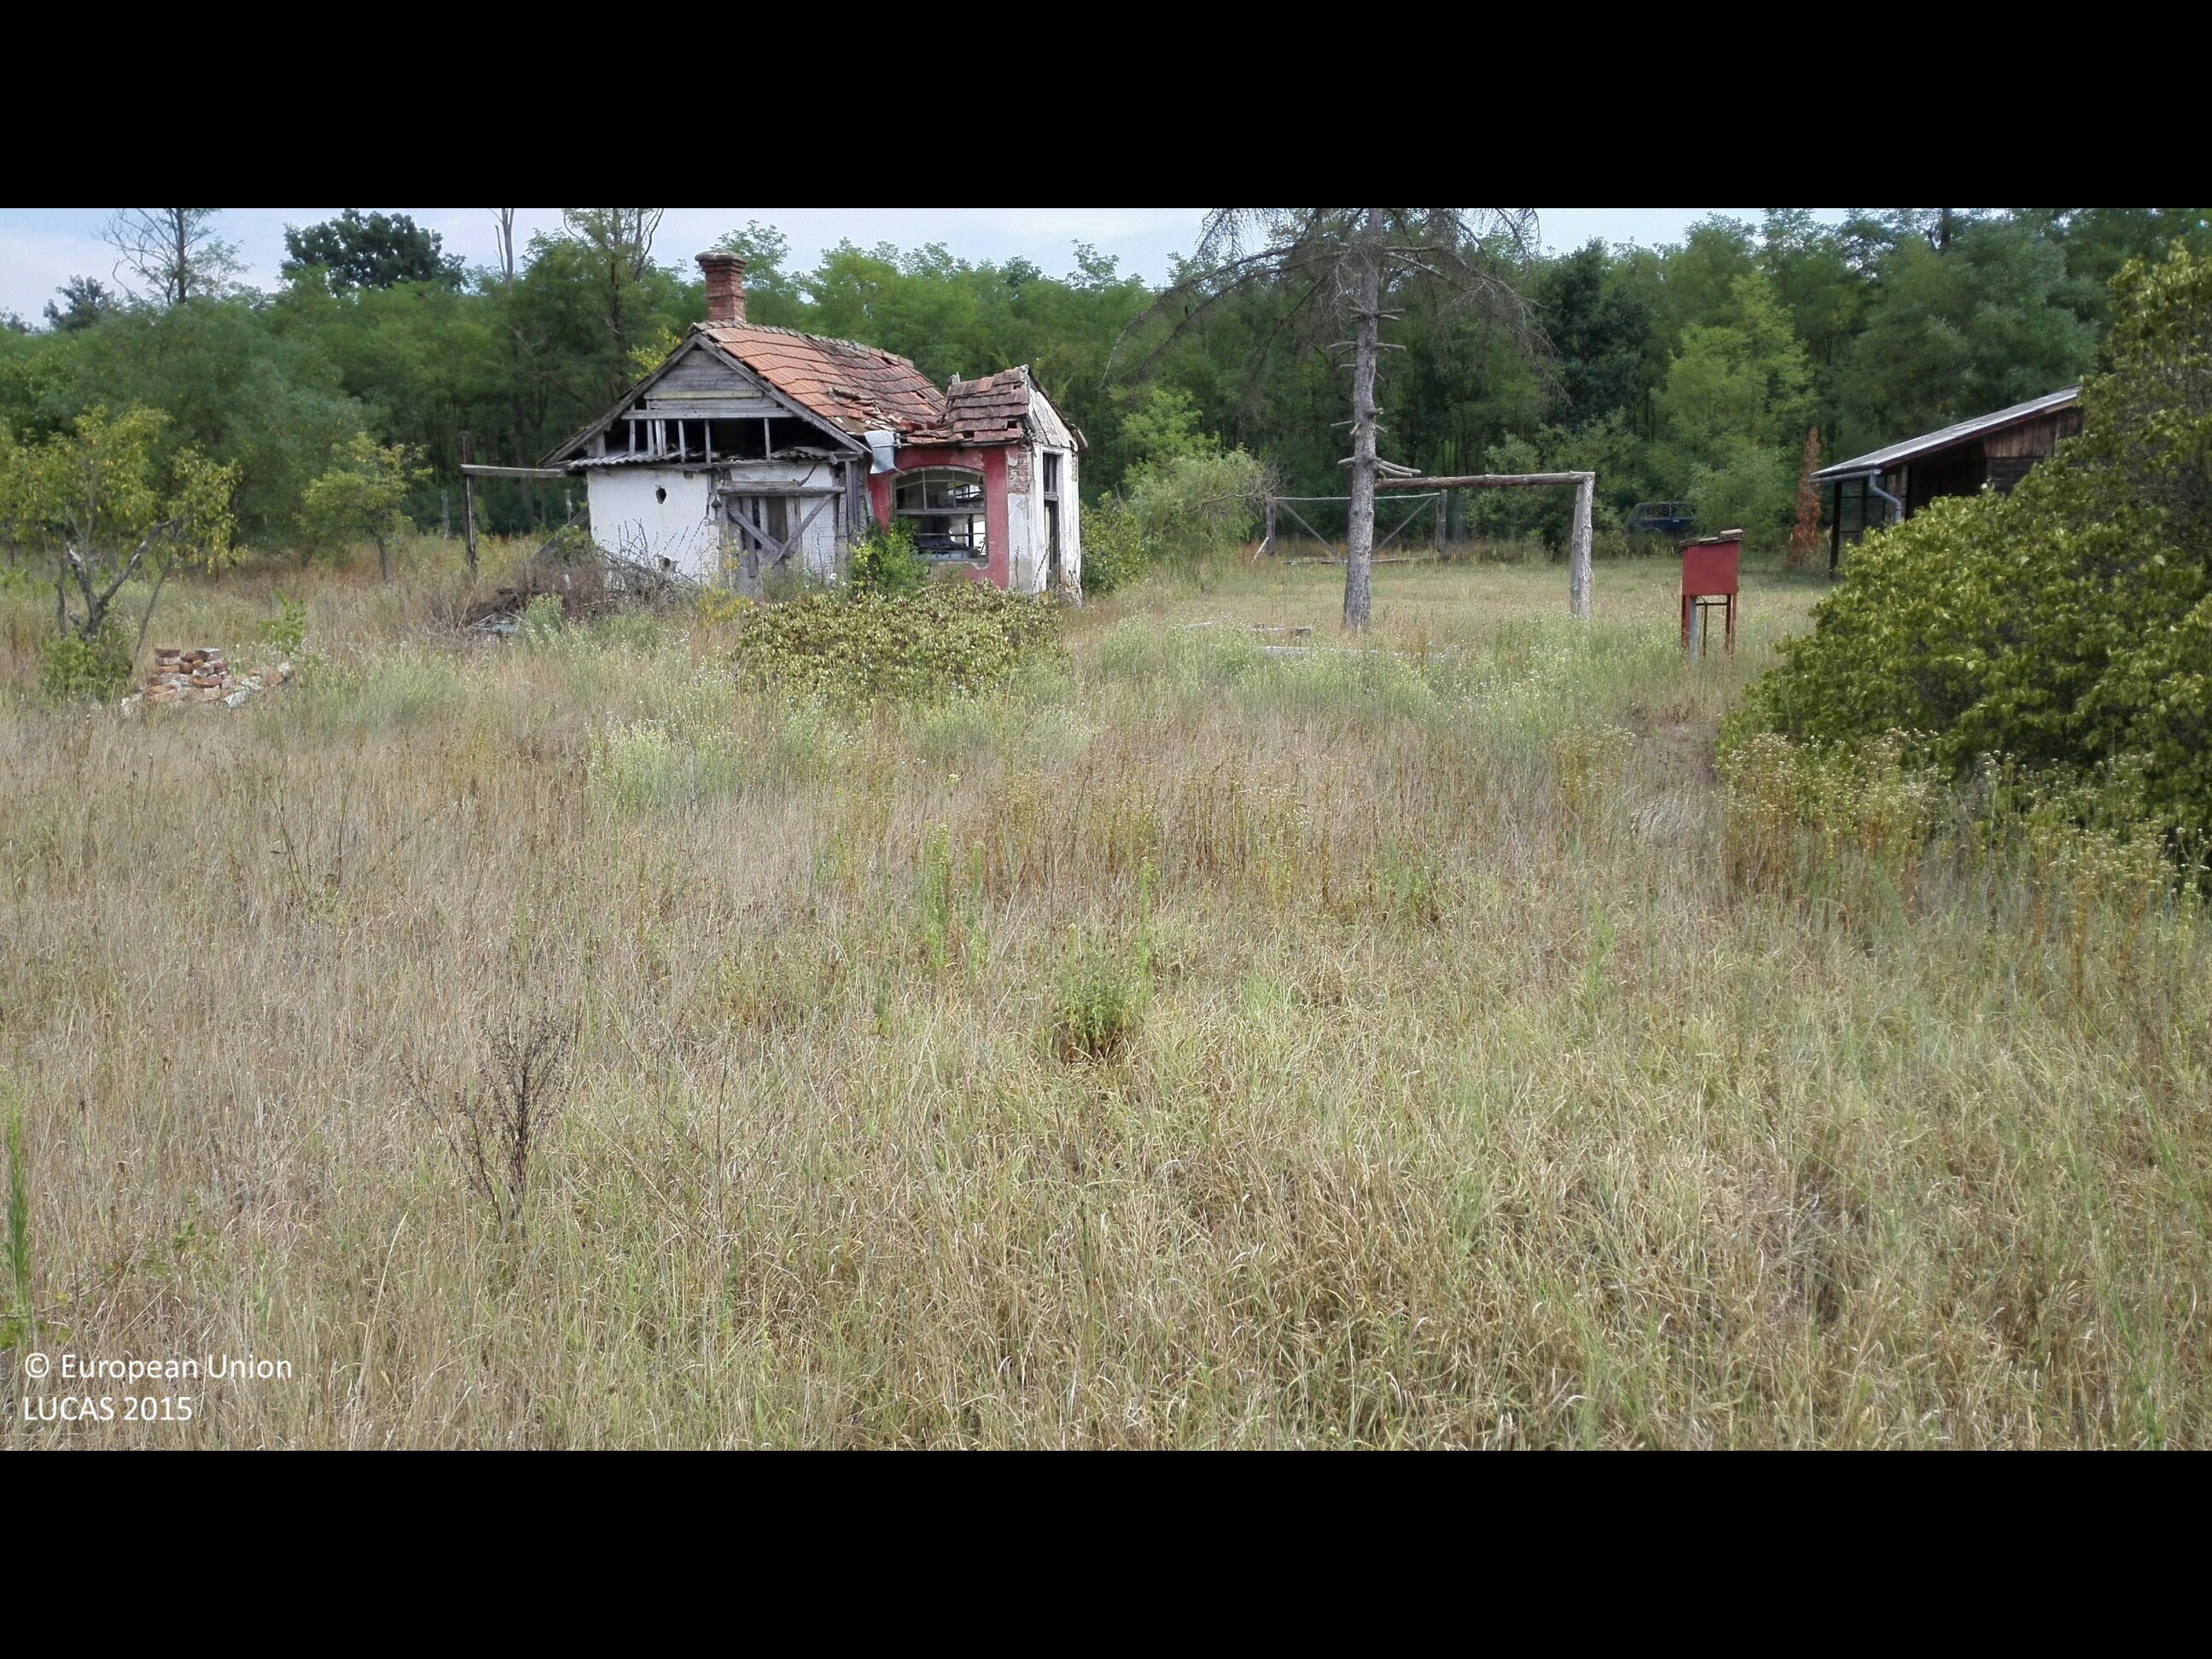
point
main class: Grassland
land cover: Grassland with sparse tree/shrub cover
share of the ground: > 75 %
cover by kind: herbaceous plants 90 %, broadleaved forest trees 5 %, shrubs 5 %
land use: Residential
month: August
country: HU
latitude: 47.5650
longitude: 21.8373
